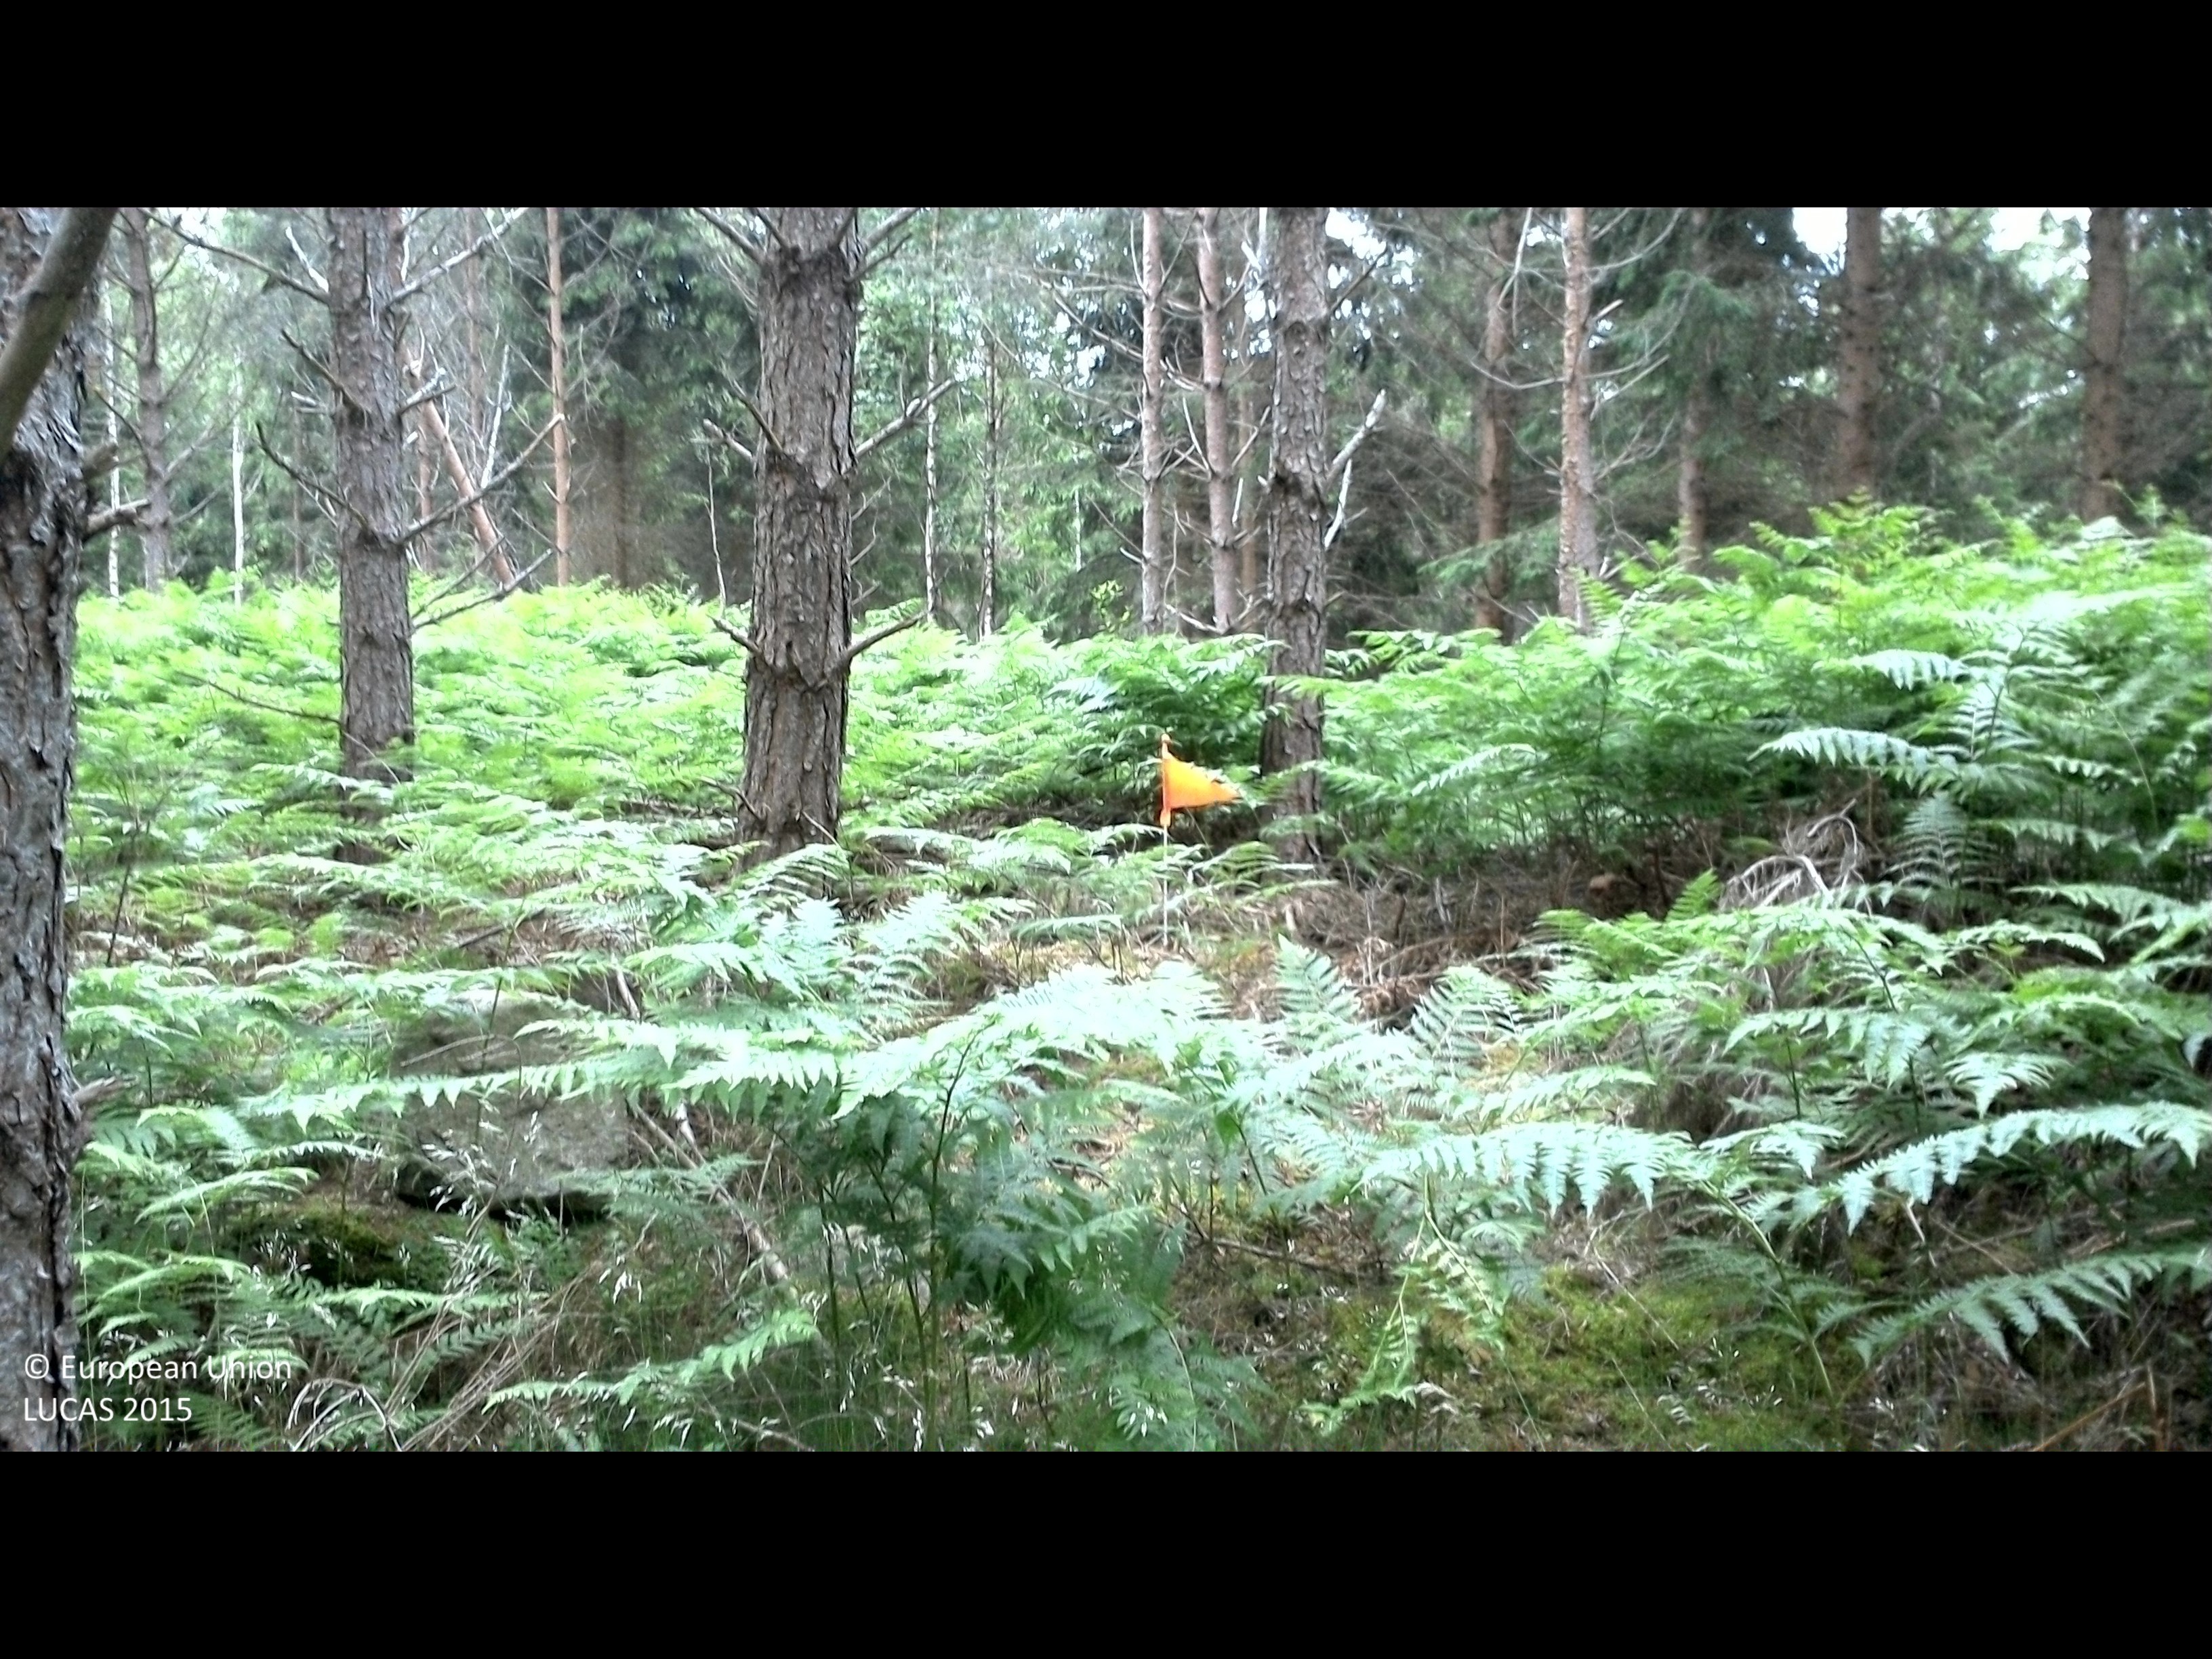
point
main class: Woodland
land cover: Pine dominated coniferous woodland
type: boreal forest
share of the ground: 50 - 75 %
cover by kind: coniferous forest trees 50 %, herbaceous plants 40 %, broadleaved forest trees 5 %, lichens and mosses 5 %
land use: Forestry
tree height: > 5 m
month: June
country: SE
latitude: 56.4940
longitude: 16.0915
